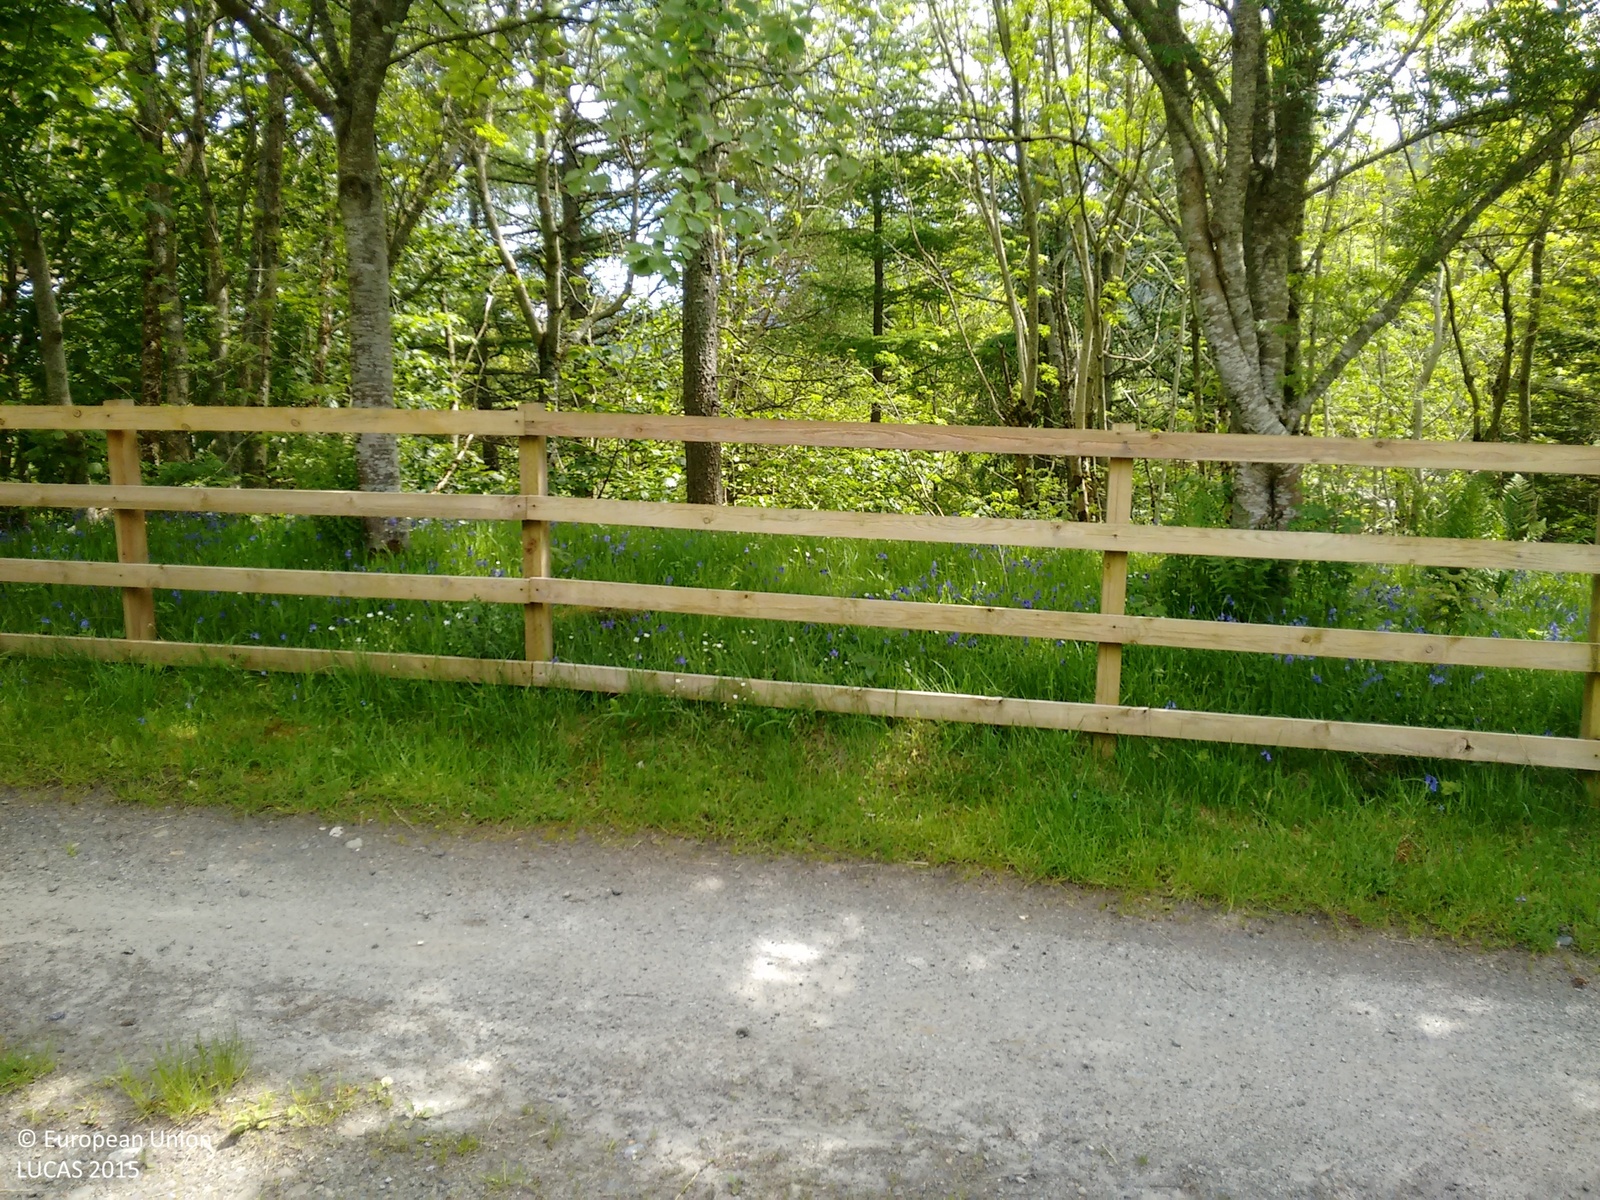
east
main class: Grassland
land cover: Grassland without tree/shrub cover
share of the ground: > 75 %
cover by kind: herbaceous plants 100 %
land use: Agriculture (excluding fallow land and kitchen gardens)
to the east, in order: Grassland without tree/shrub cover; Electric lines; Grassland without tree/shrub cover; Fences; Lines of trees; Grass margins; Tracks; Grass margins; Fences; Broadleaved woodland; Inland fresh running water; Broadleaved woodland
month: June
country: GB
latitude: 56.5951
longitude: -4.0761
